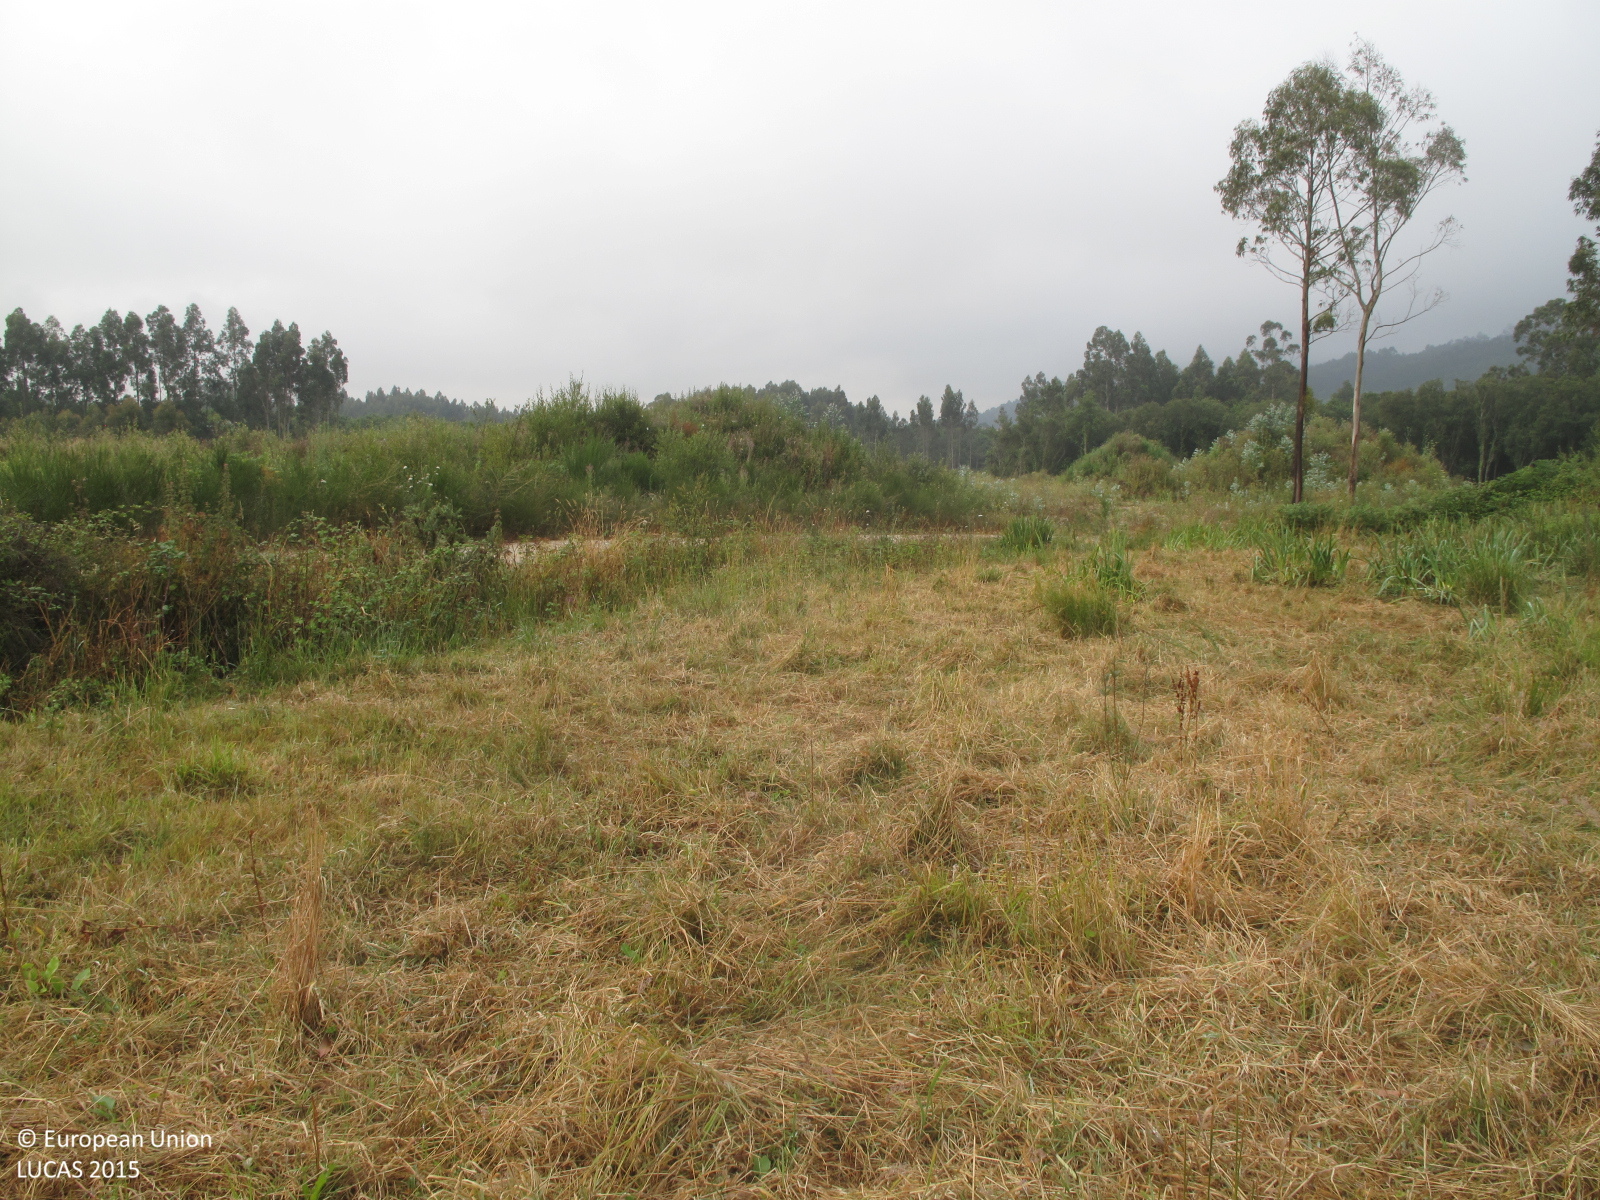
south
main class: Grassland
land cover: Grassland without tree/shrub cover
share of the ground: > 75 %
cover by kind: herbaceous plants 100 %
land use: Agriculture (excluding fallow land and kitchen gardens)
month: July
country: ES
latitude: 43.5307
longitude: -8.2310
